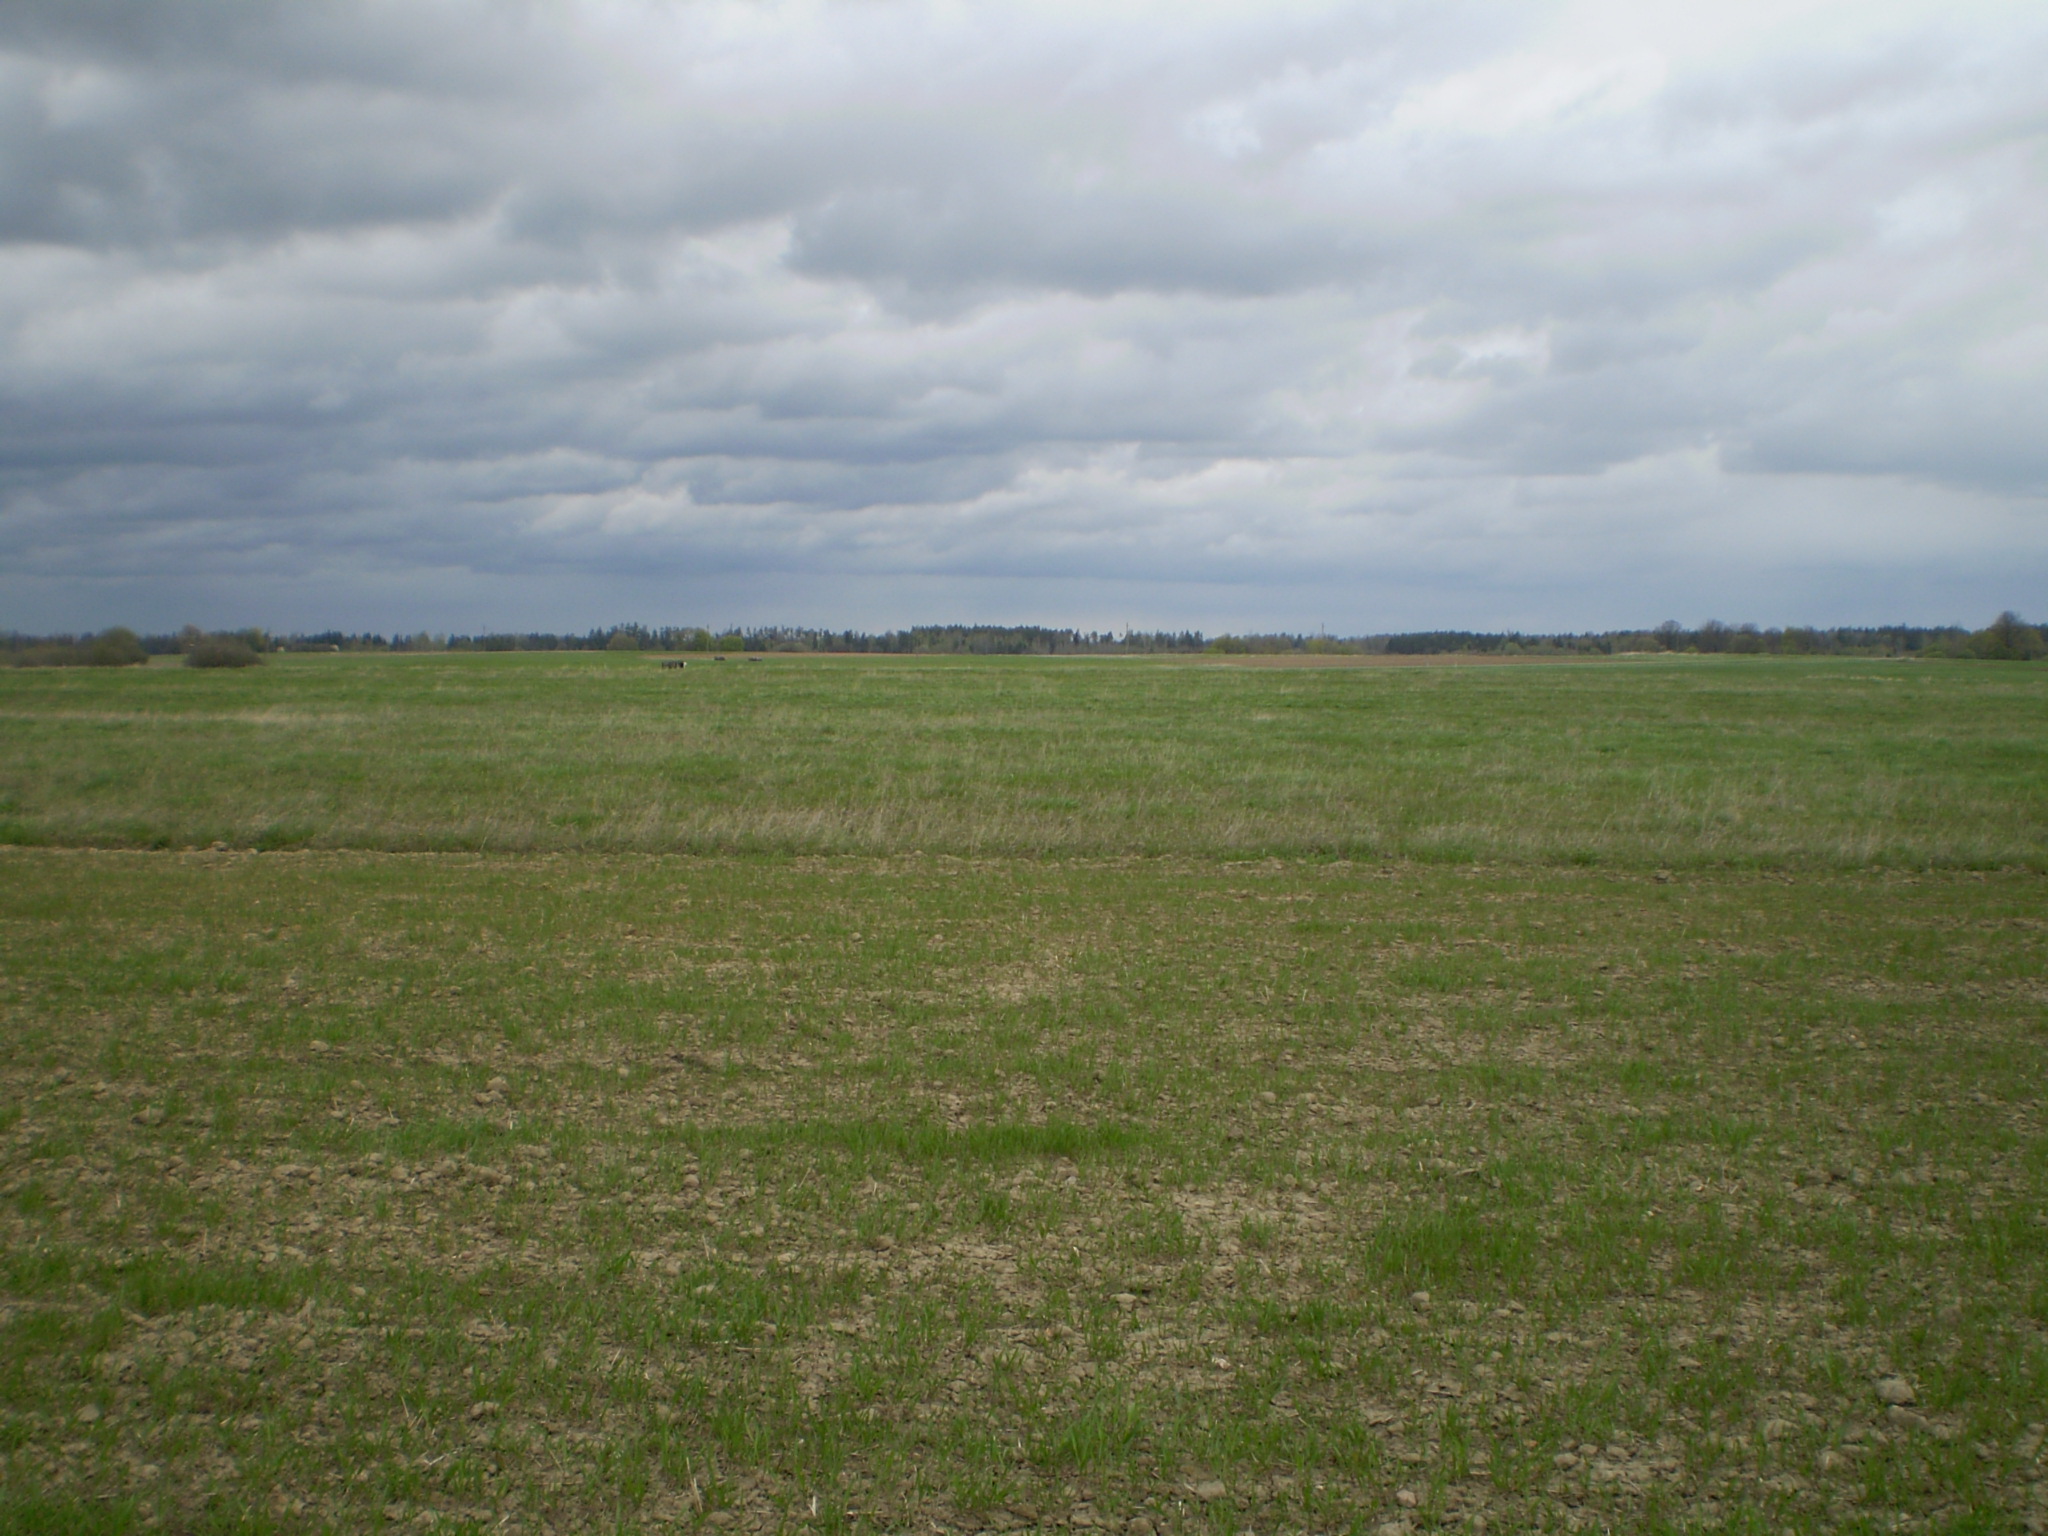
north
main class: Cropland
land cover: Common wheat
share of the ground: 50 - 75 %
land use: Agriculture (excluding fallow land and kitchen gardens)
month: May
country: LT
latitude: 56.4112
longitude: 22.1262
